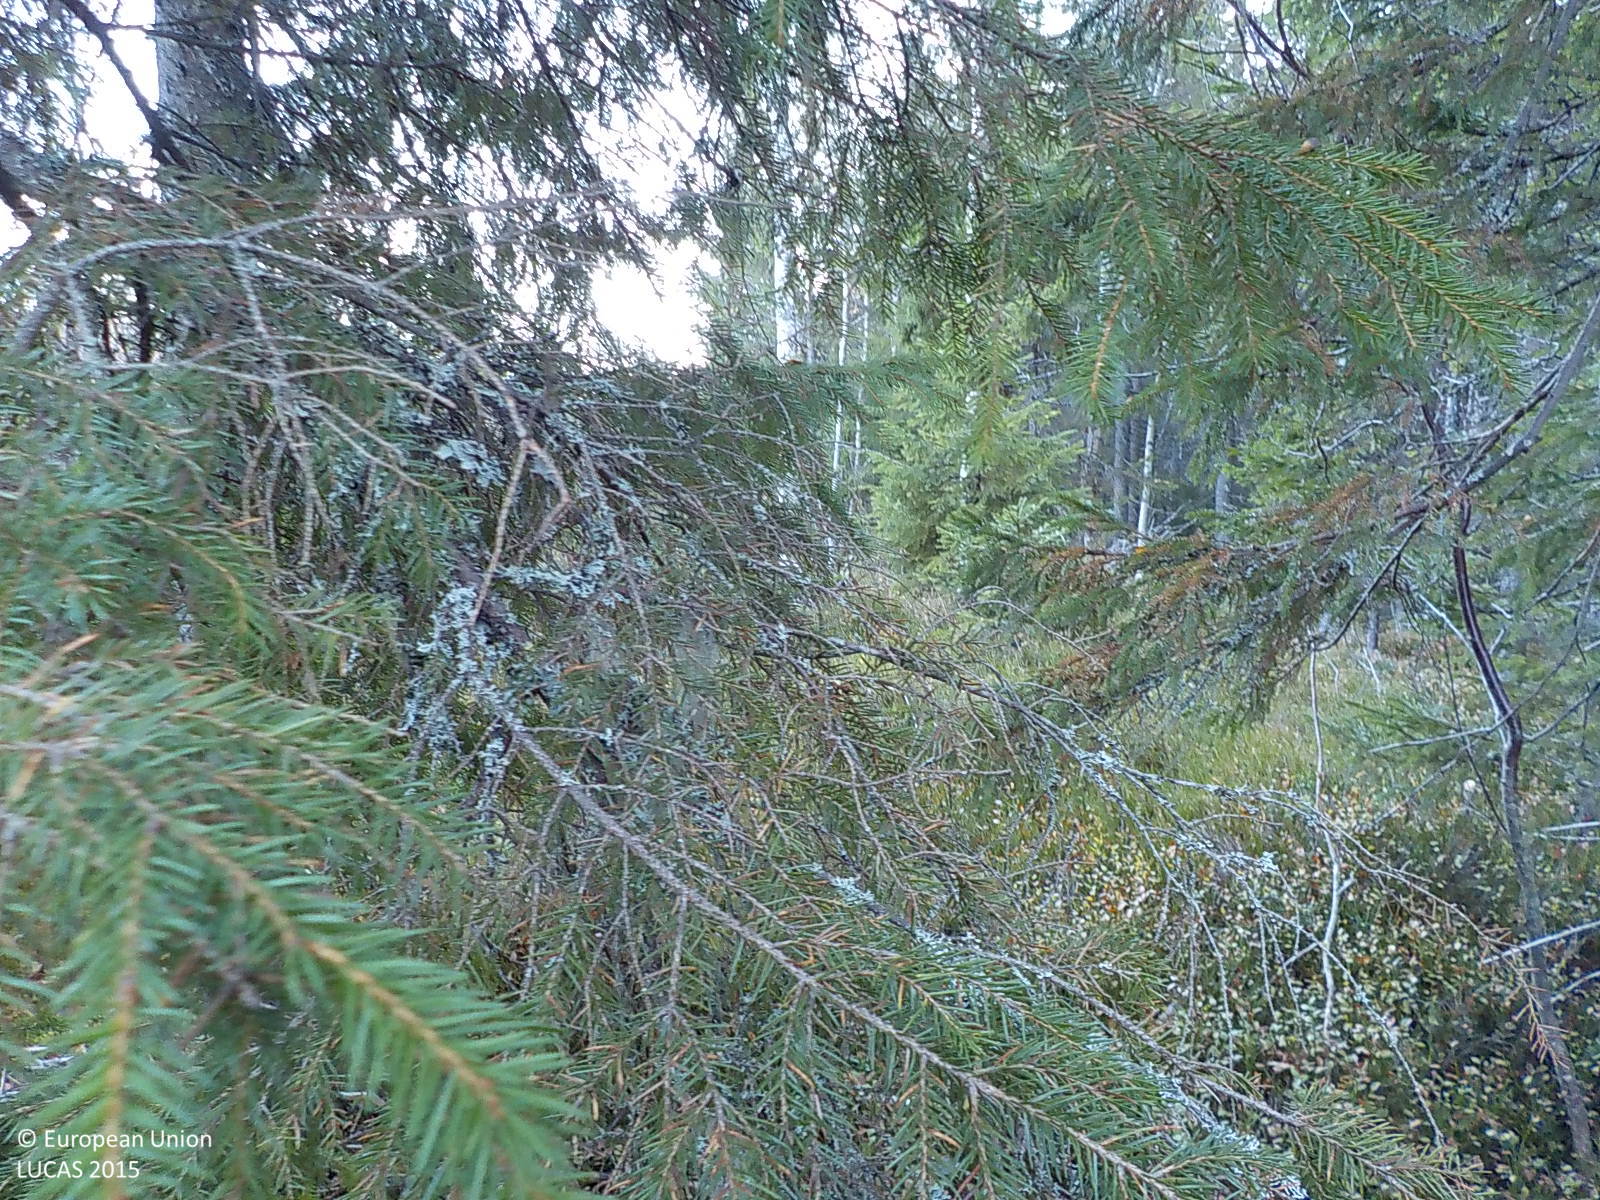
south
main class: Woodland
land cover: Spruce dominated mixed woodland
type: boreal forest
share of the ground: > 75 %
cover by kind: coniferous forest trees 55 %, broadleaved forest trees 20 %, shrubs 15 %, herbaceous plants 10 %
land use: Forestry
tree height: > 5 m
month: October
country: SE
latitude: 63.1995
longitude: 18.3070
